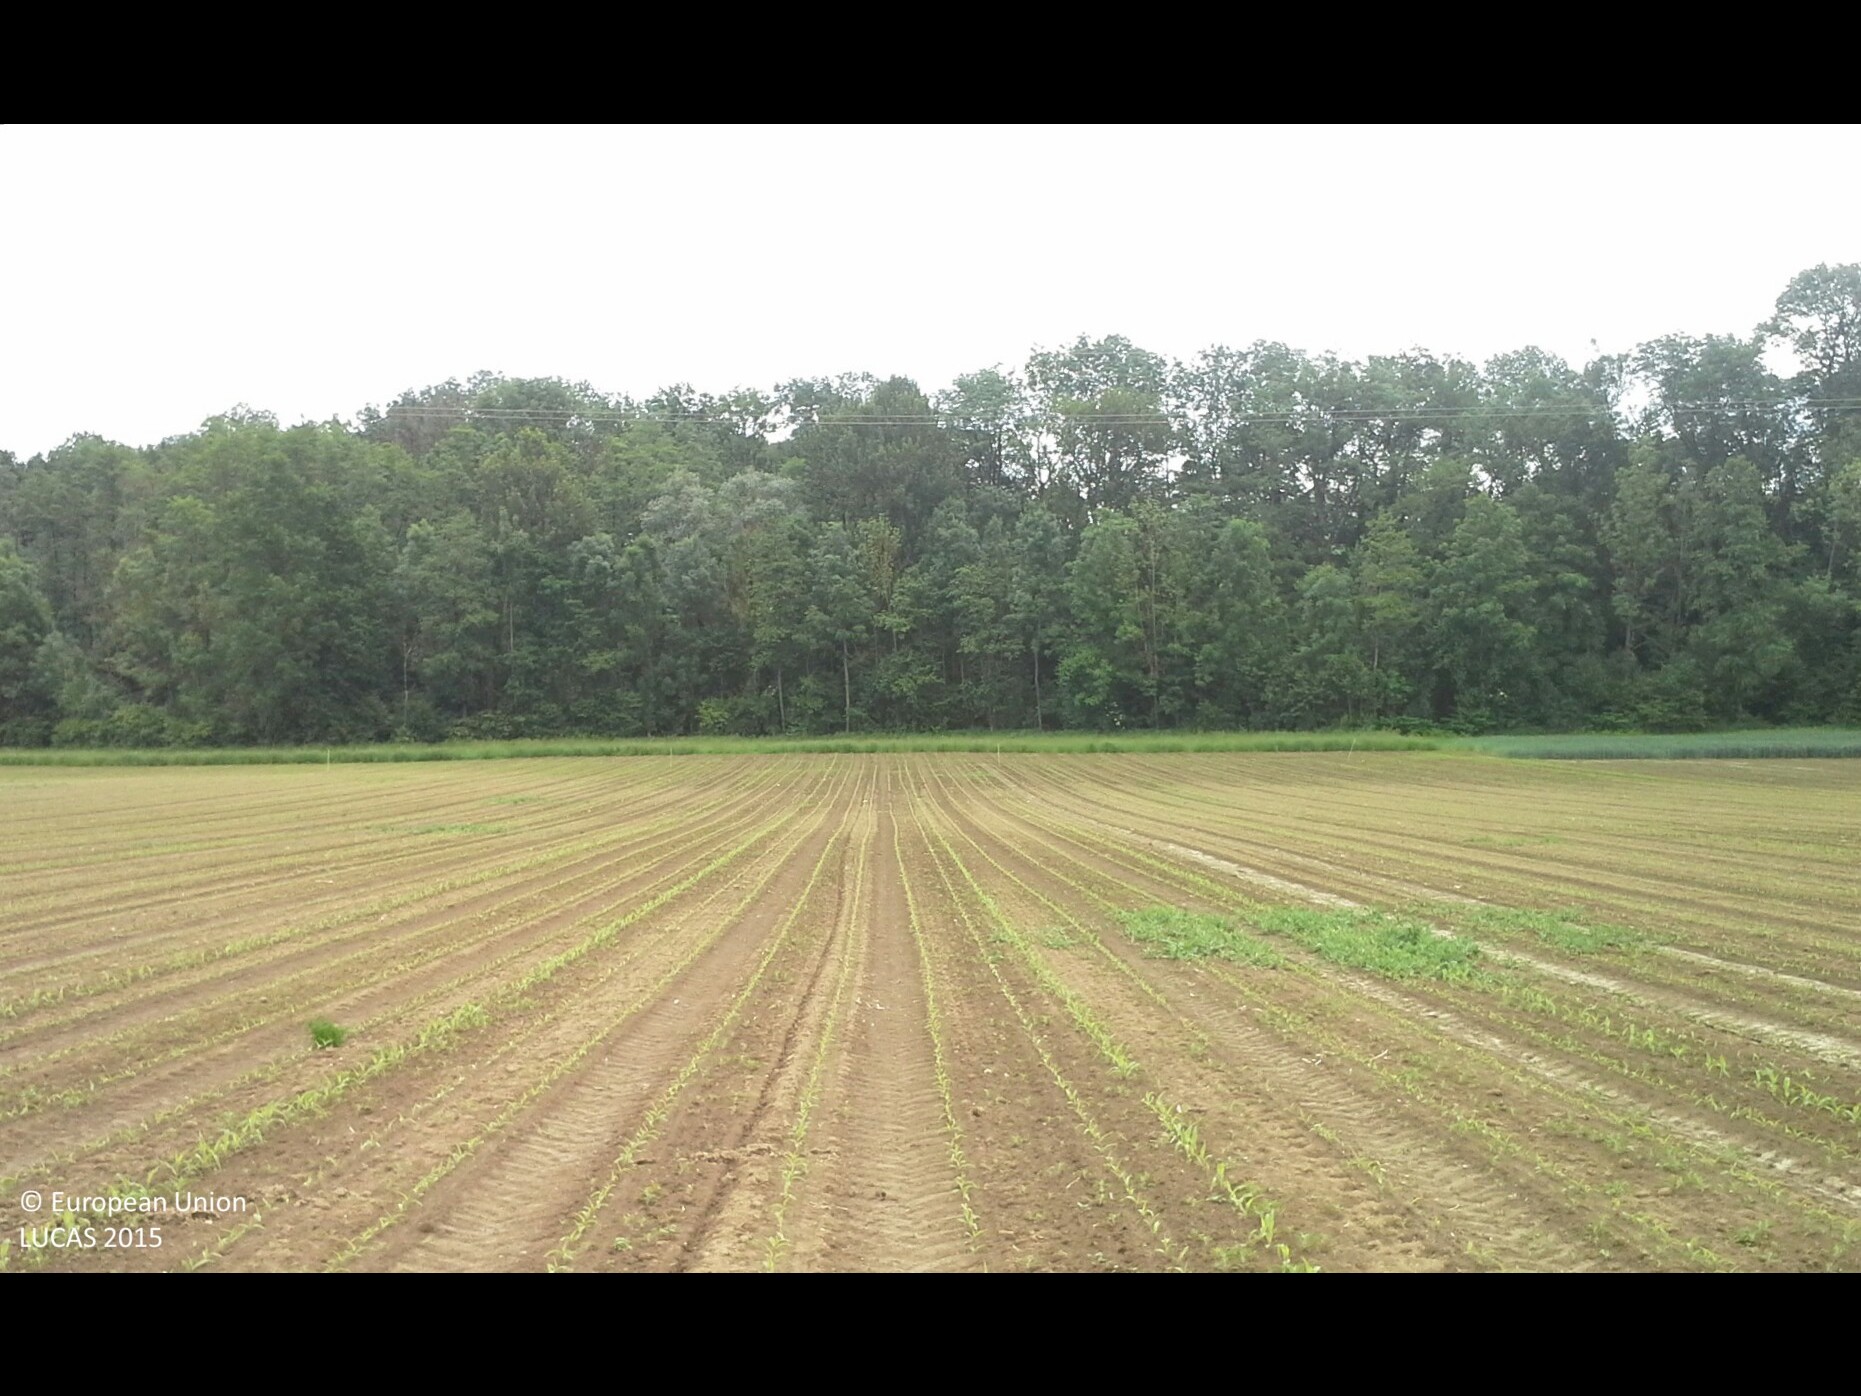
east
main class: Cropland
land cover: Maize
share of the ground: < 10 %
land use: Agriculture (excluding fallow land and kitchen gardens)
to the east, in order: Maize; Electric lines; Maize; Barley; Grassland without tree/shrub cover; Tracks; Grassland without tree/shrub cover; Broadleaved woodland; Rivers and streams; Broadleaved woodland; Tracks; Grass margins; Rape and turnip rape
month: May
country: AT
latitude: 48.1529
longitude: 14.4226
